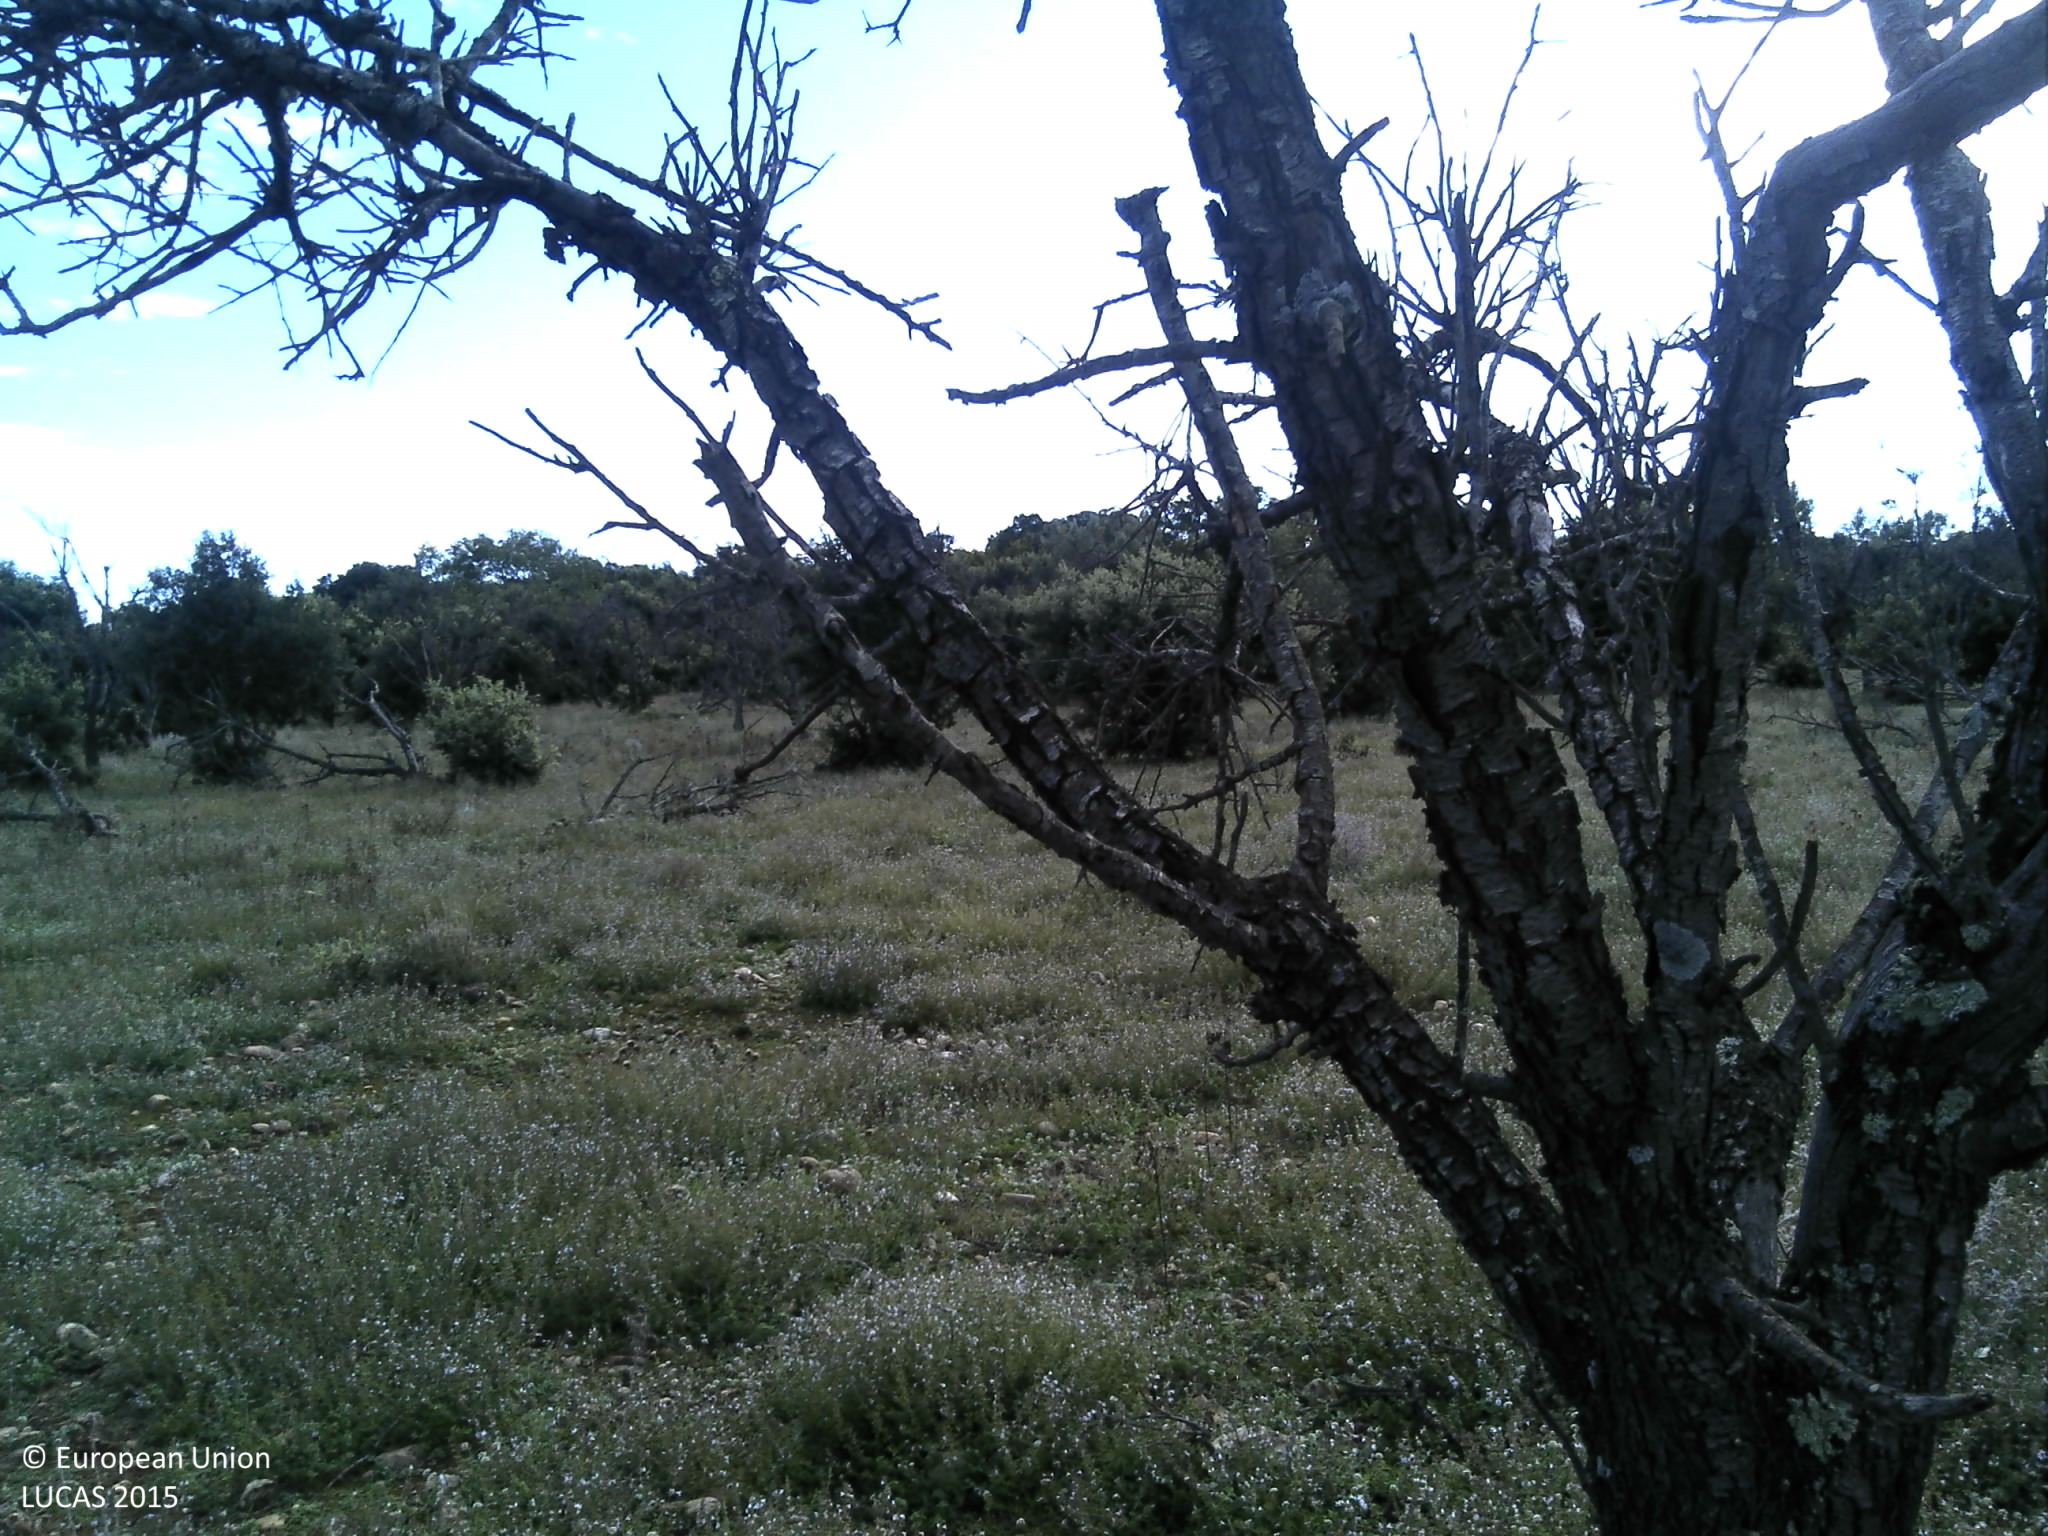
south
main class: Grassland
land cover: Grassland with sparse tree/shrub cover
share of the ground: > 75 %
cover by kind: herbaceous plants 95 %, broadleaved forest trees 5 %
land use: Abandoned areas
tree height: < 5 m
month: October
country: FR
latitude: 43.6258
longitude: 4.8416
